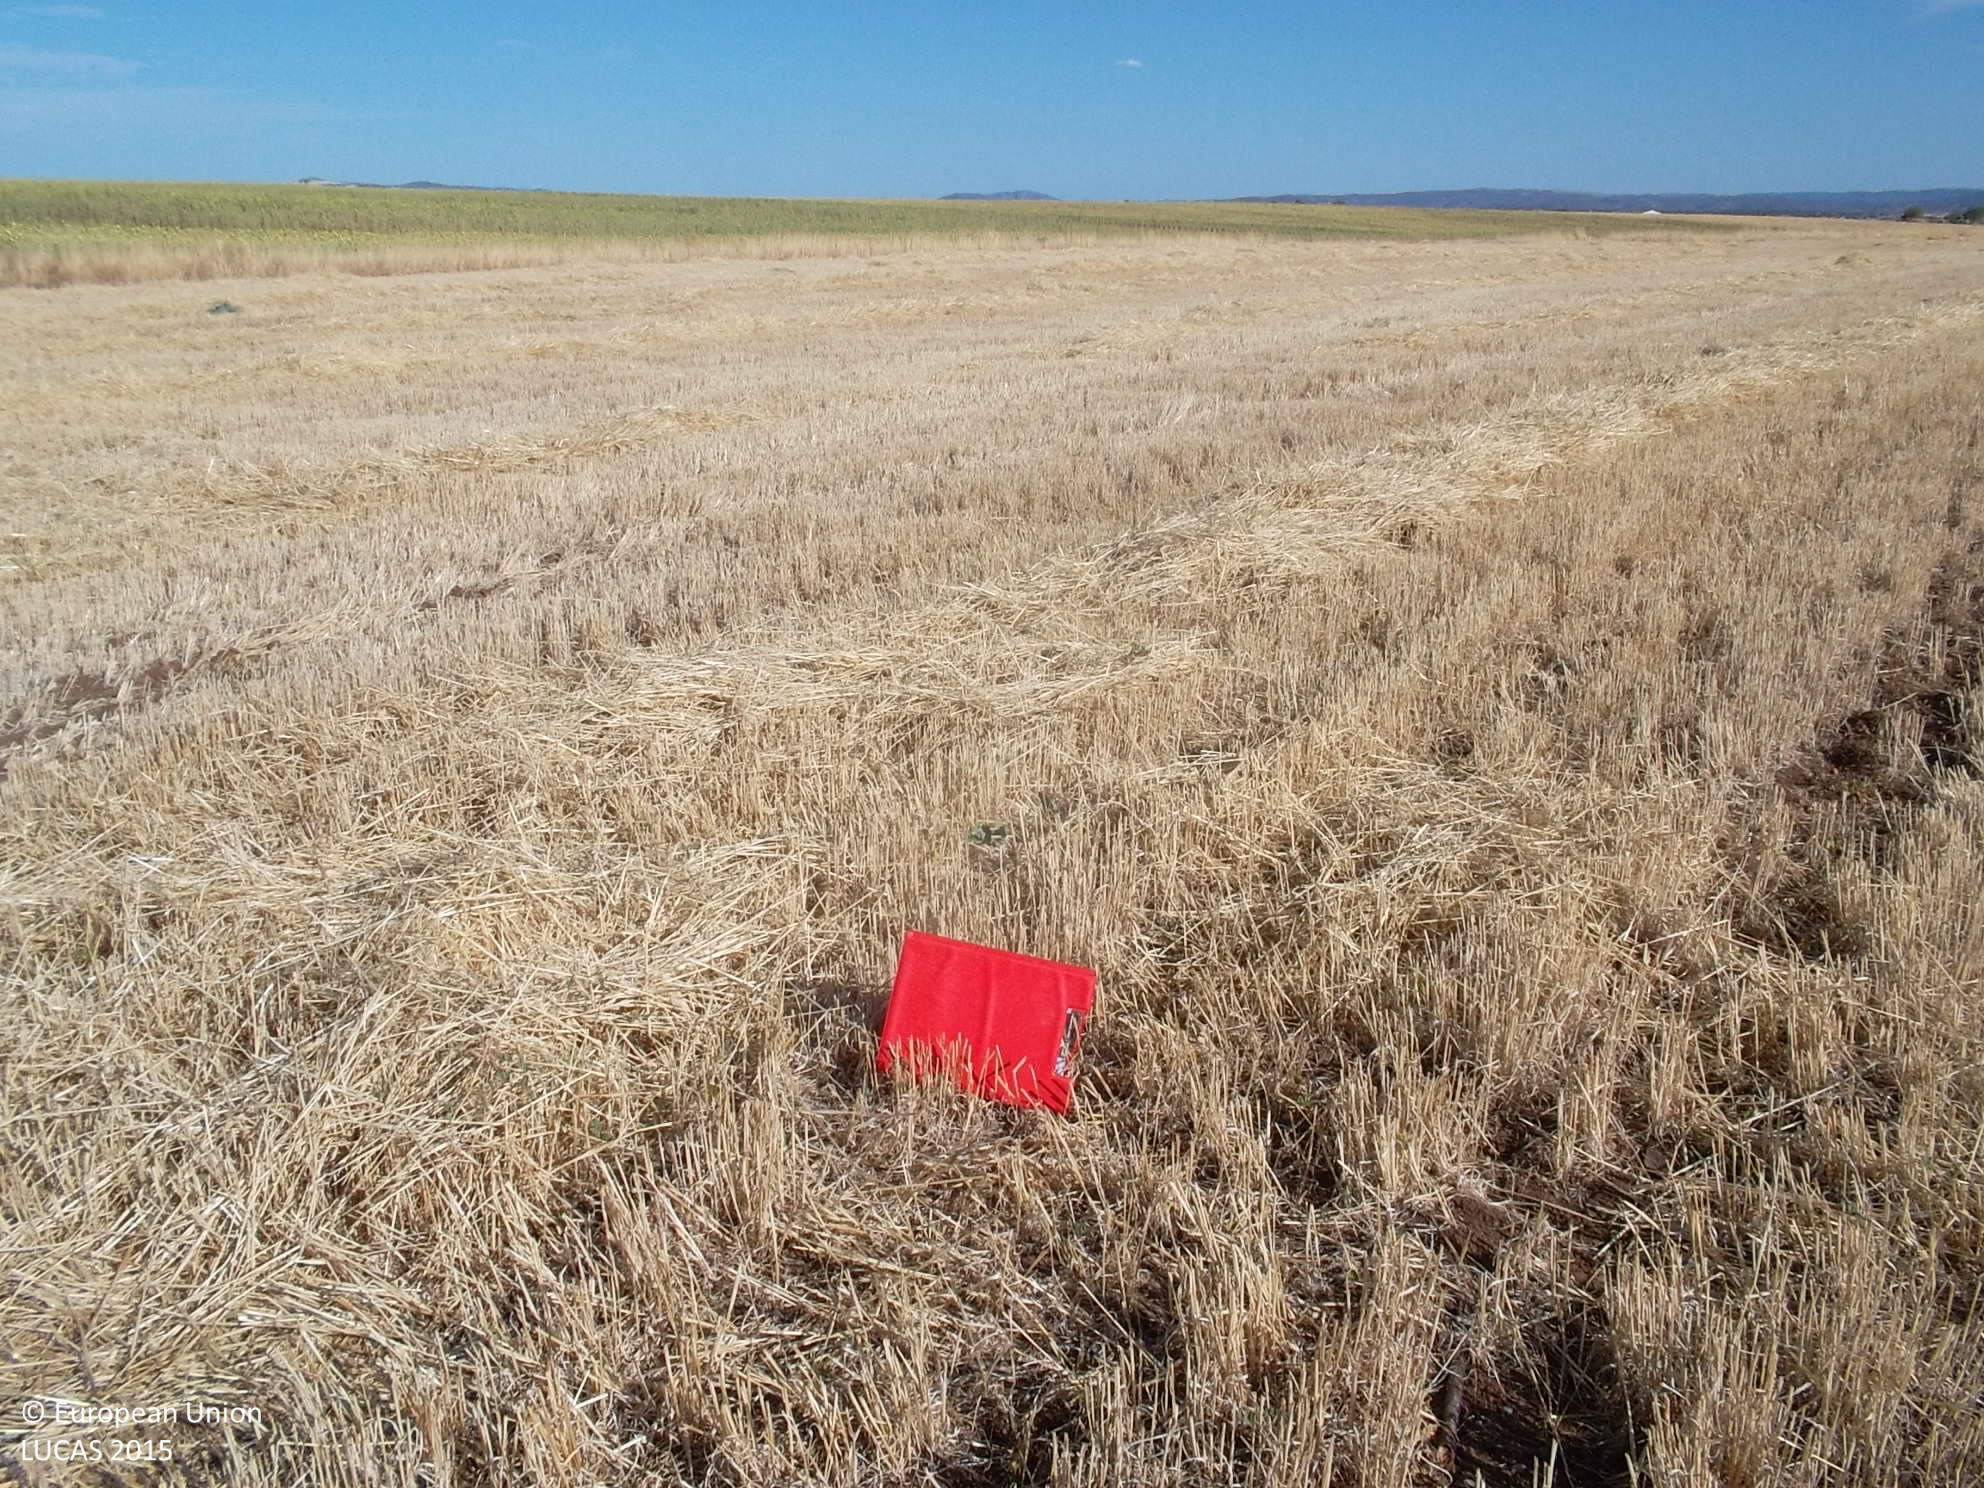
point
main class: Cropland
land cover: Barley
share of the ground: < 10 %
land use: Agriculture (excluding fallow land and kitchen gardens)
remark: Harvested field
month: July
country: ES
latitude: 38.3008
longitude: -5.6663
